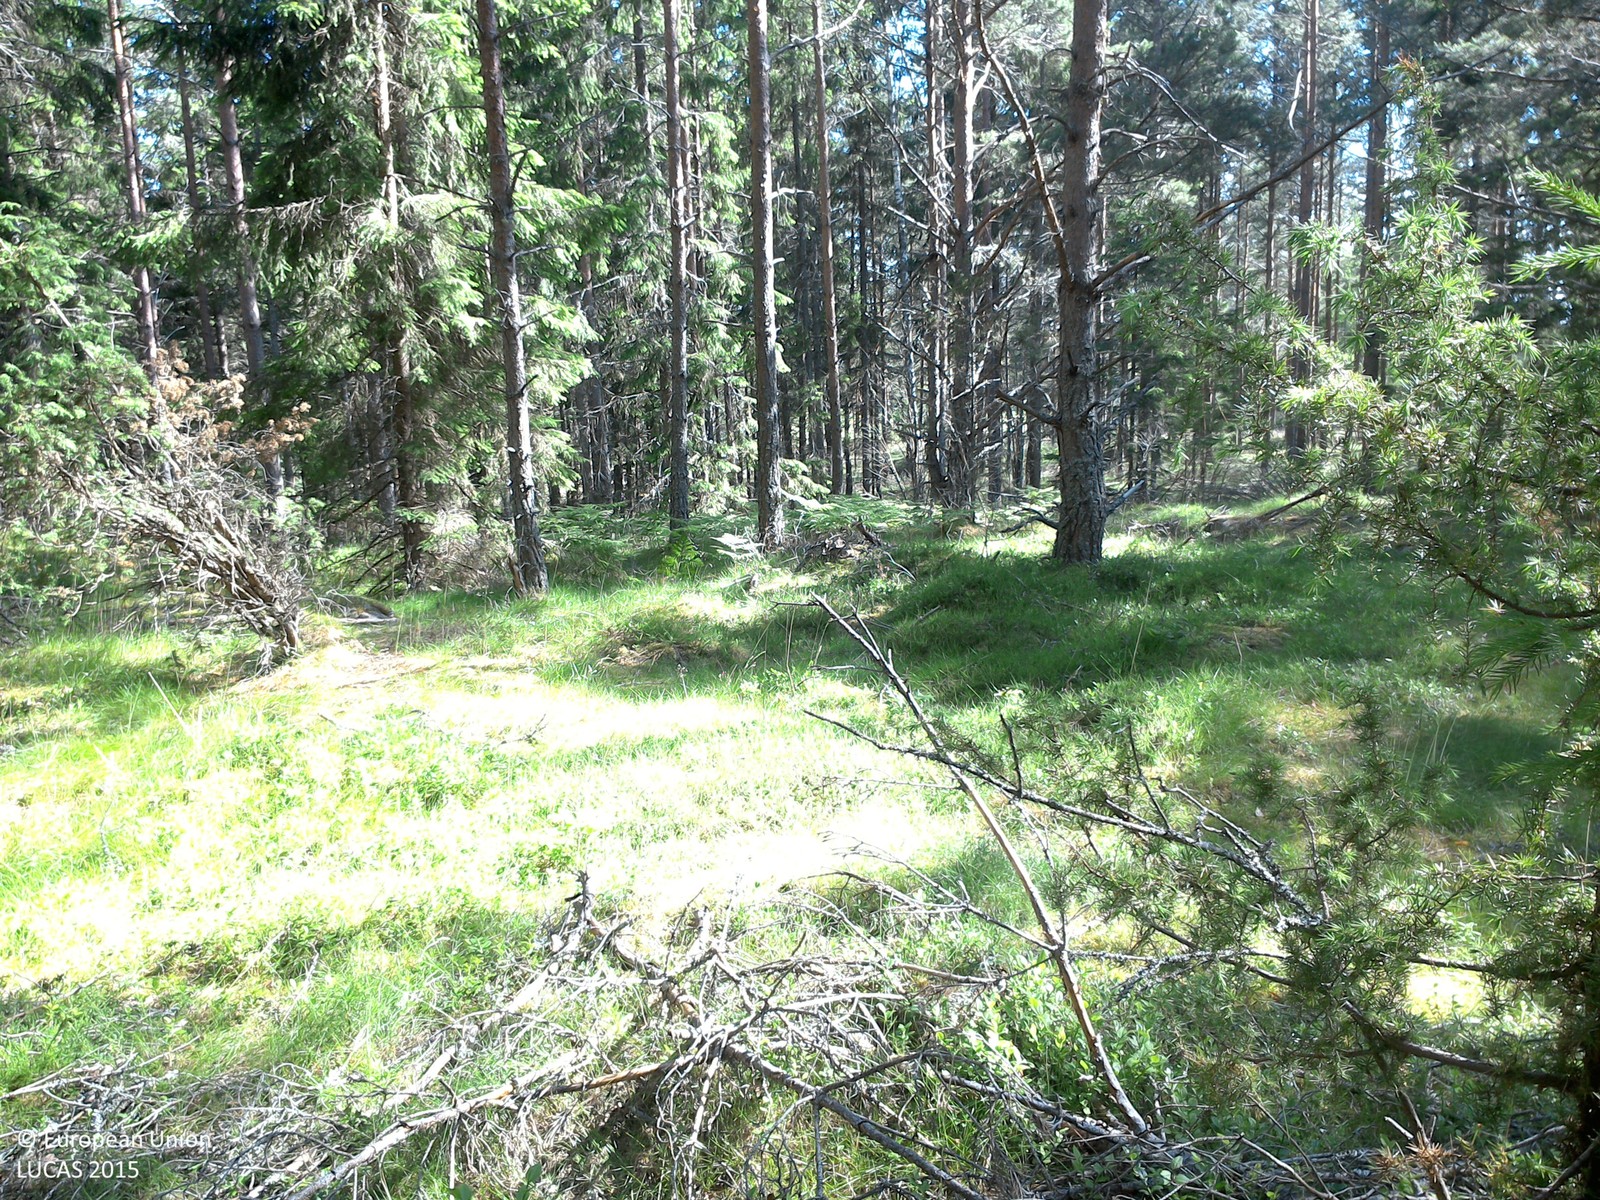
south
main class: Woodland
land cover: Pine dominated coniferous woodland
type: boreal forest
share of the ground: 50 - 75 %
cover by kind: coniferous forest trees 65 %, lichens and mosses 20 %, herbaceous plants 10 %, broadleaved forest trees 5 %
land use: Forestry
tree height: > 5 m
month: June
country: SE
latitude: 58.2499
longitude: 15.5323
